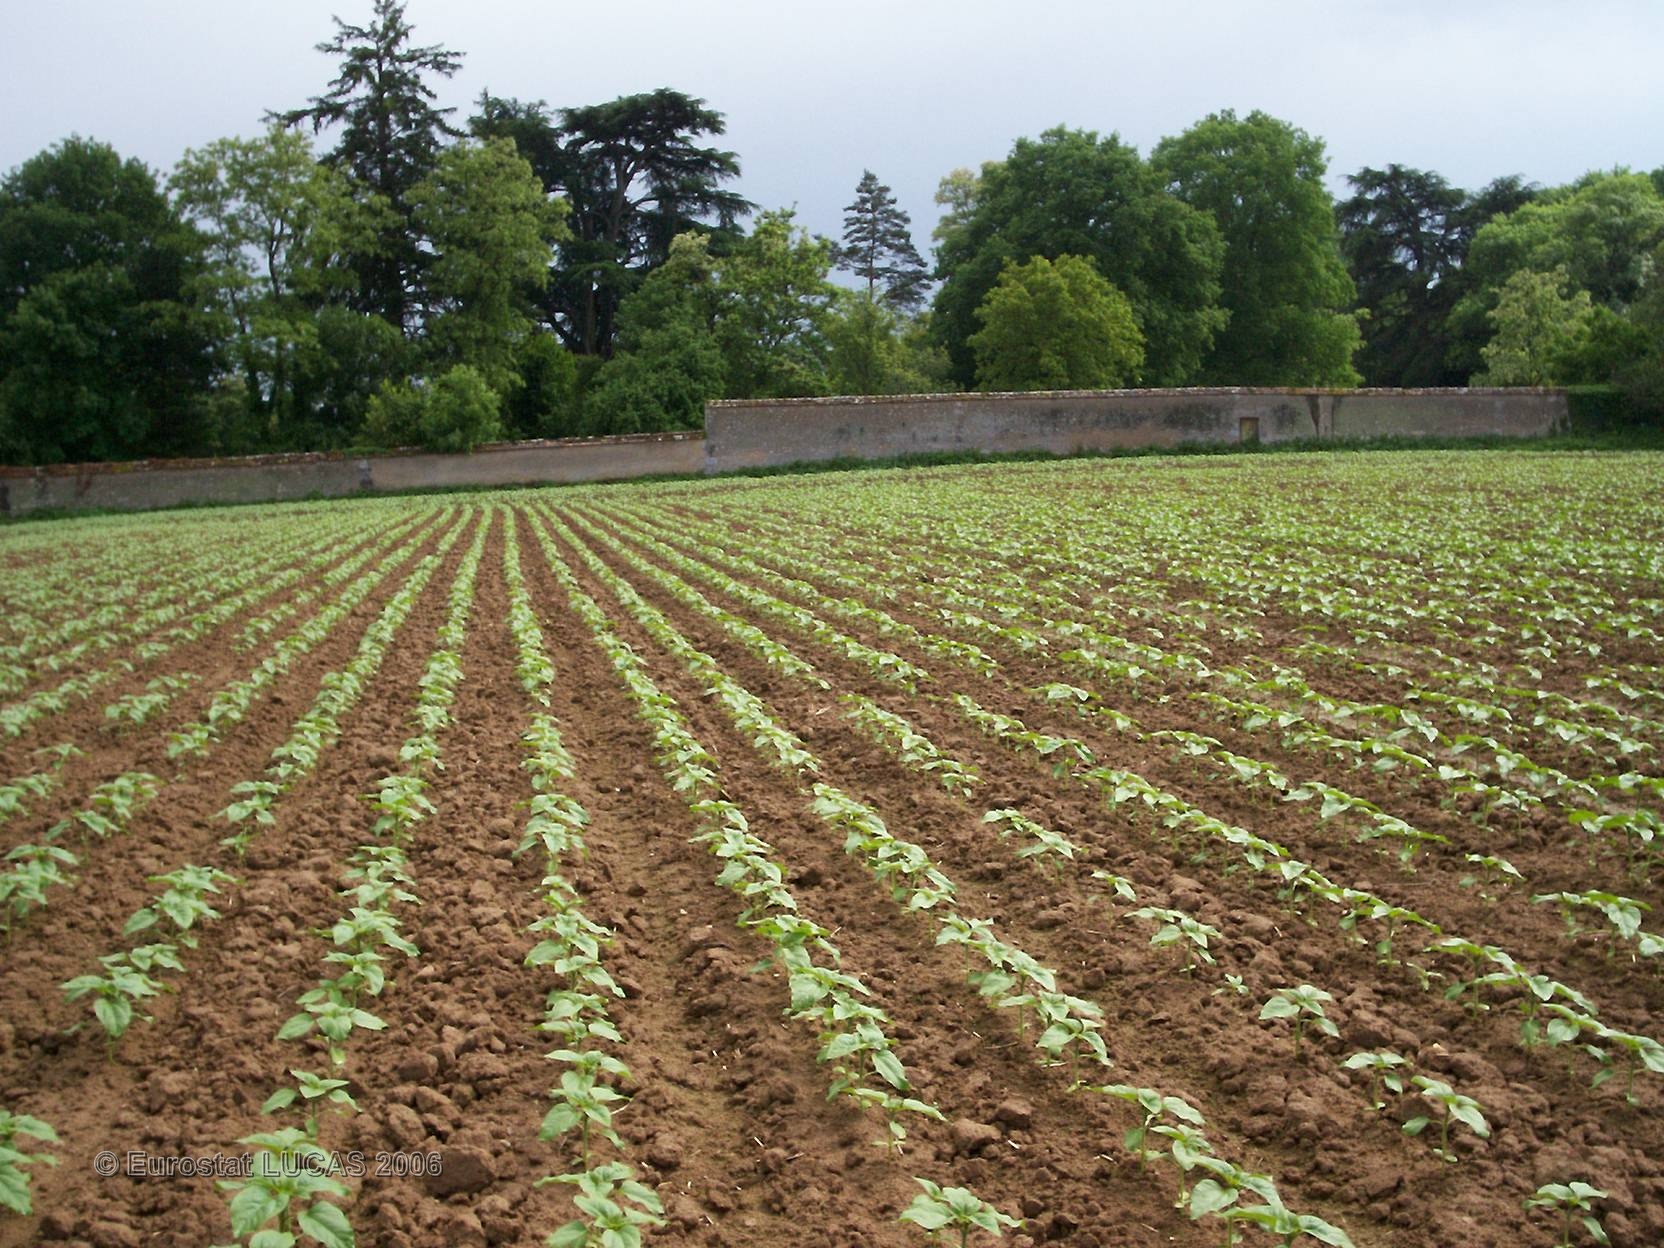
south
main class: Cropland
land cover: Sunflower
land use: Agriculture (excluding fallow land and kitchen gardens)
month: May
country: FR
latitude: 47.1514
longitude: 2.9922
